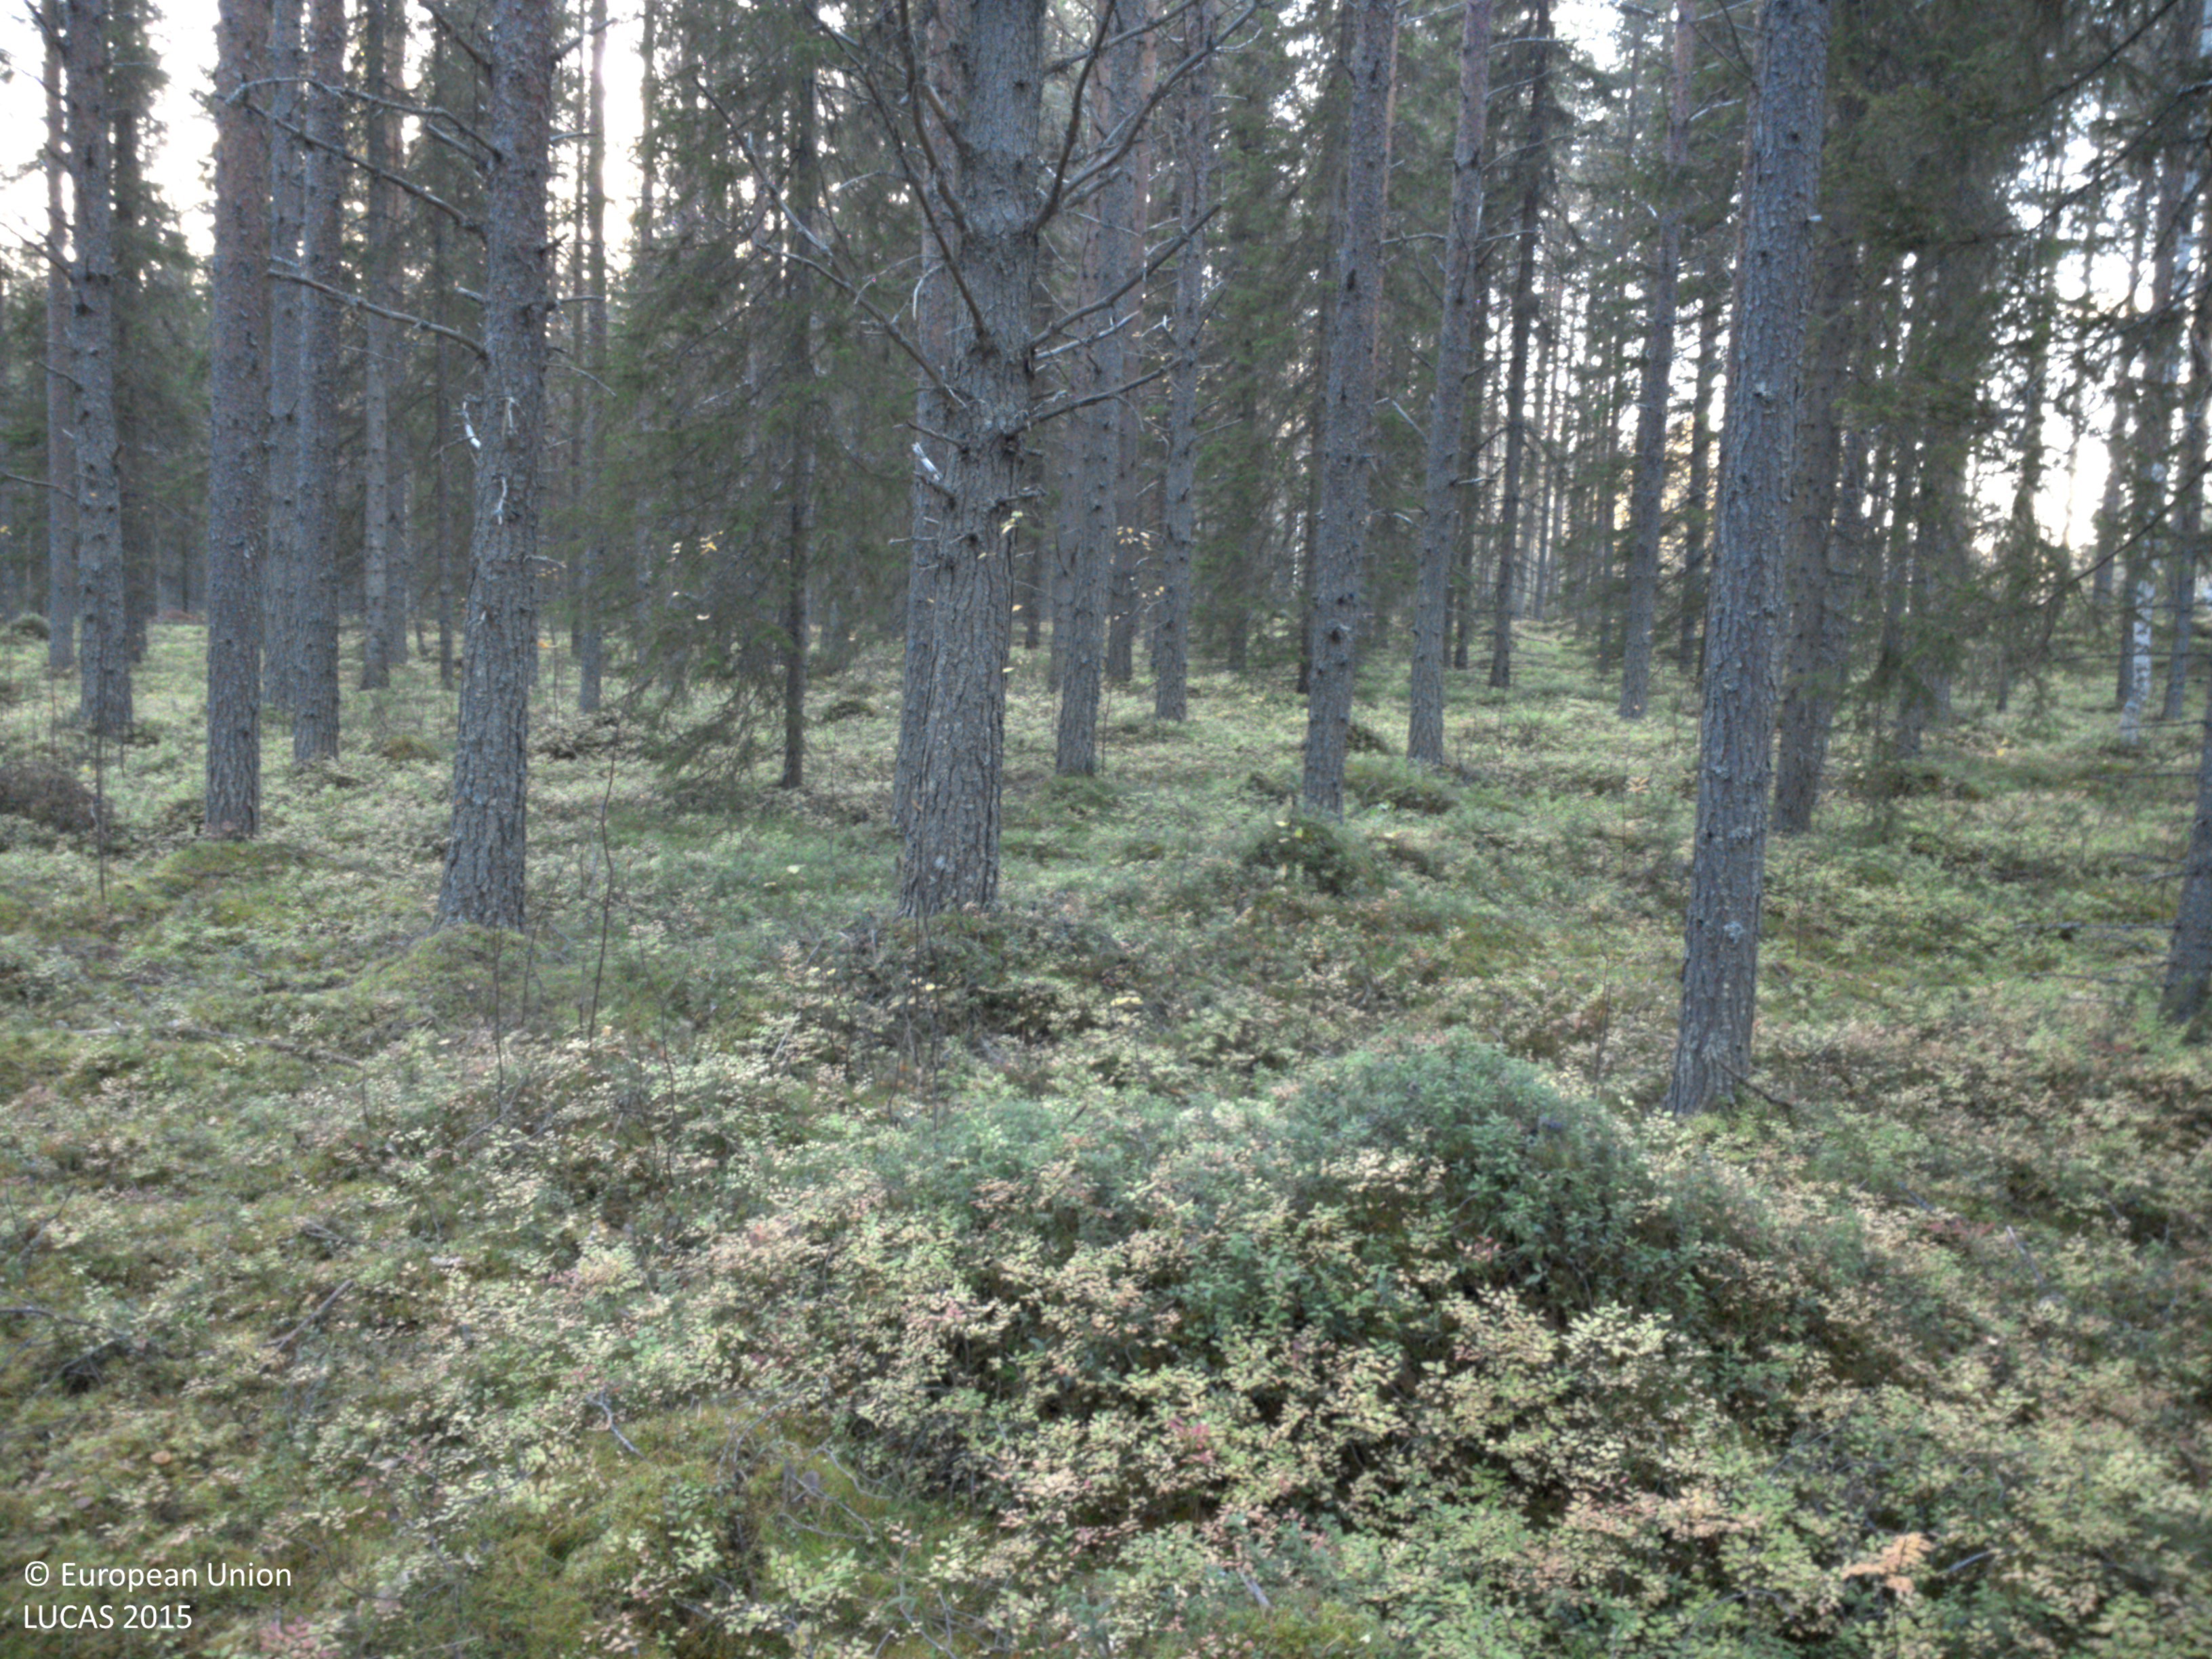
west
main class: Woodland
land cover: Pine dominated mixed woodland
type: boreal forest
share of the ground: 50 - 75 %
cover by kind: coniferous forest trees 45 %, shrubs 35 %, broadleaved forest trees 15 %, lichens and mosses 5 %
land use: Forestry
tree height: > 5 m
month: September
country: SE
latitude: 64.9273
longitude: 18.2762
